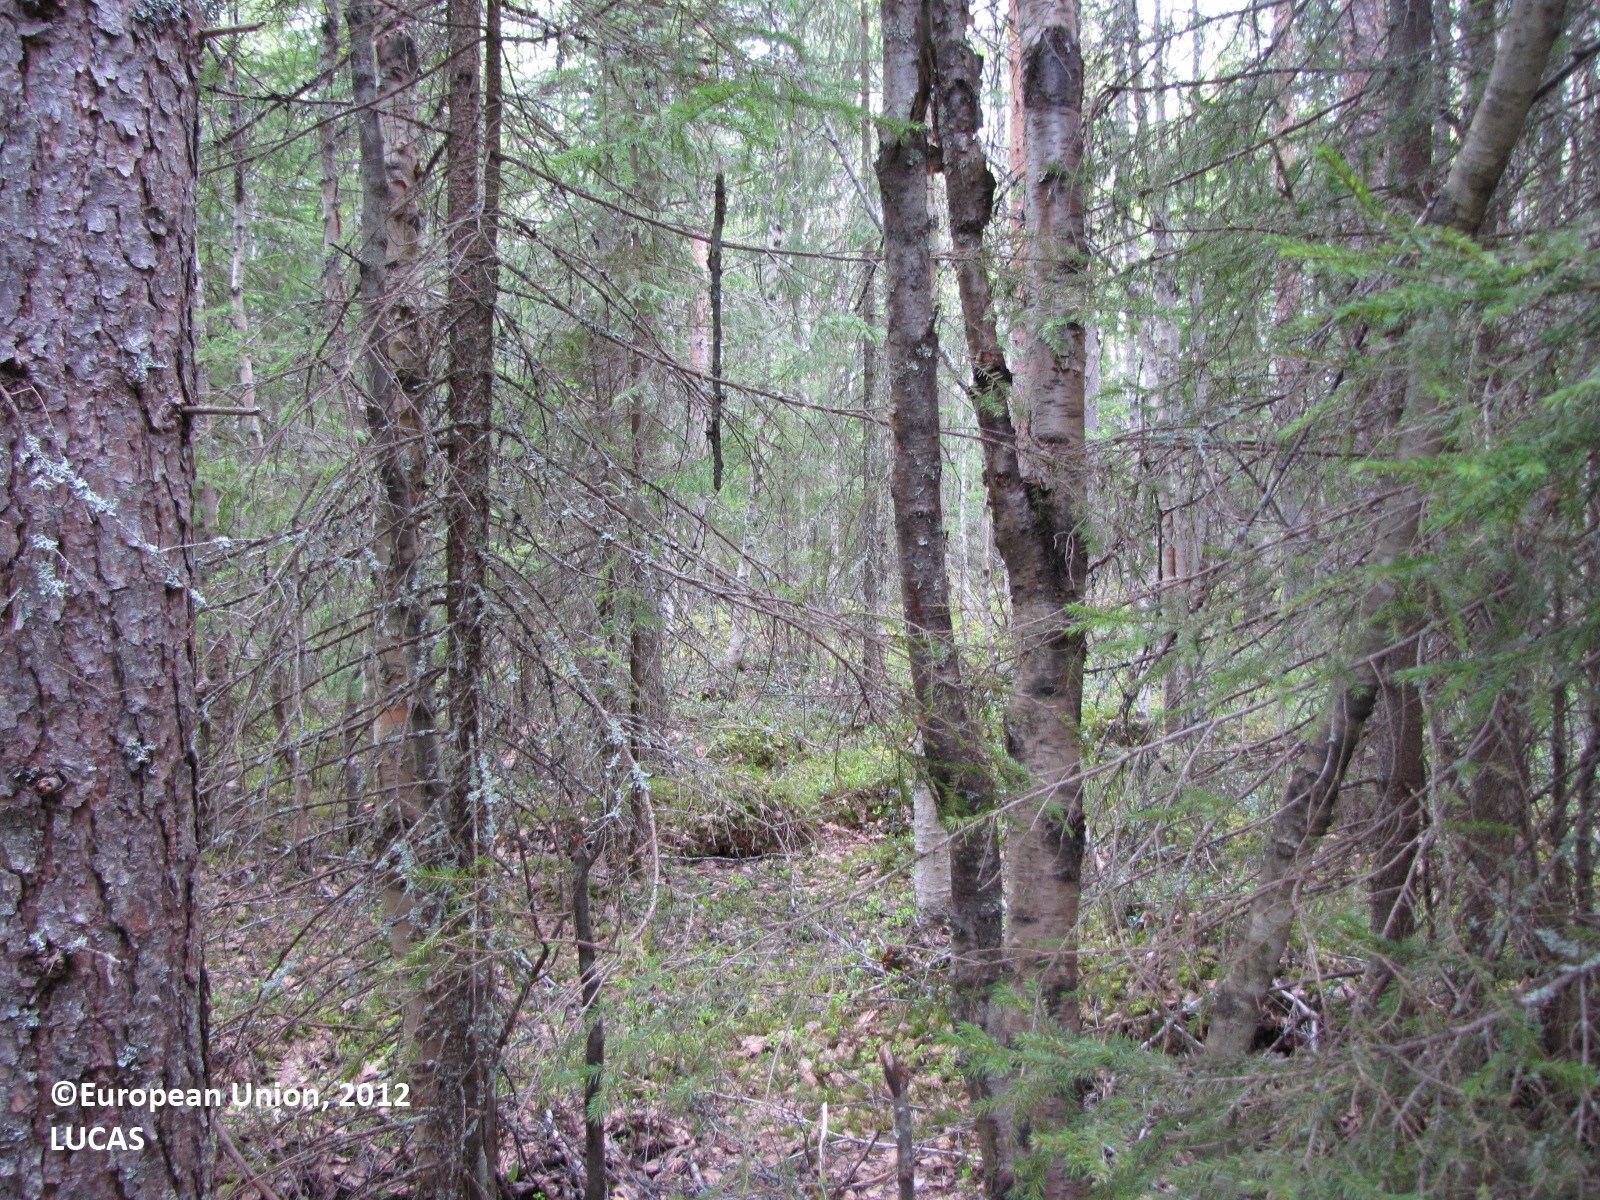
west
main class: Woodland
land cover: Spruce dominated mixed woodland
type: boreal forest
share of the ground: > 75 %
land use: Forestry
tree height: > 5 m
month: June
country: FI
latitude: 65.8110
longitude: 24.5109
